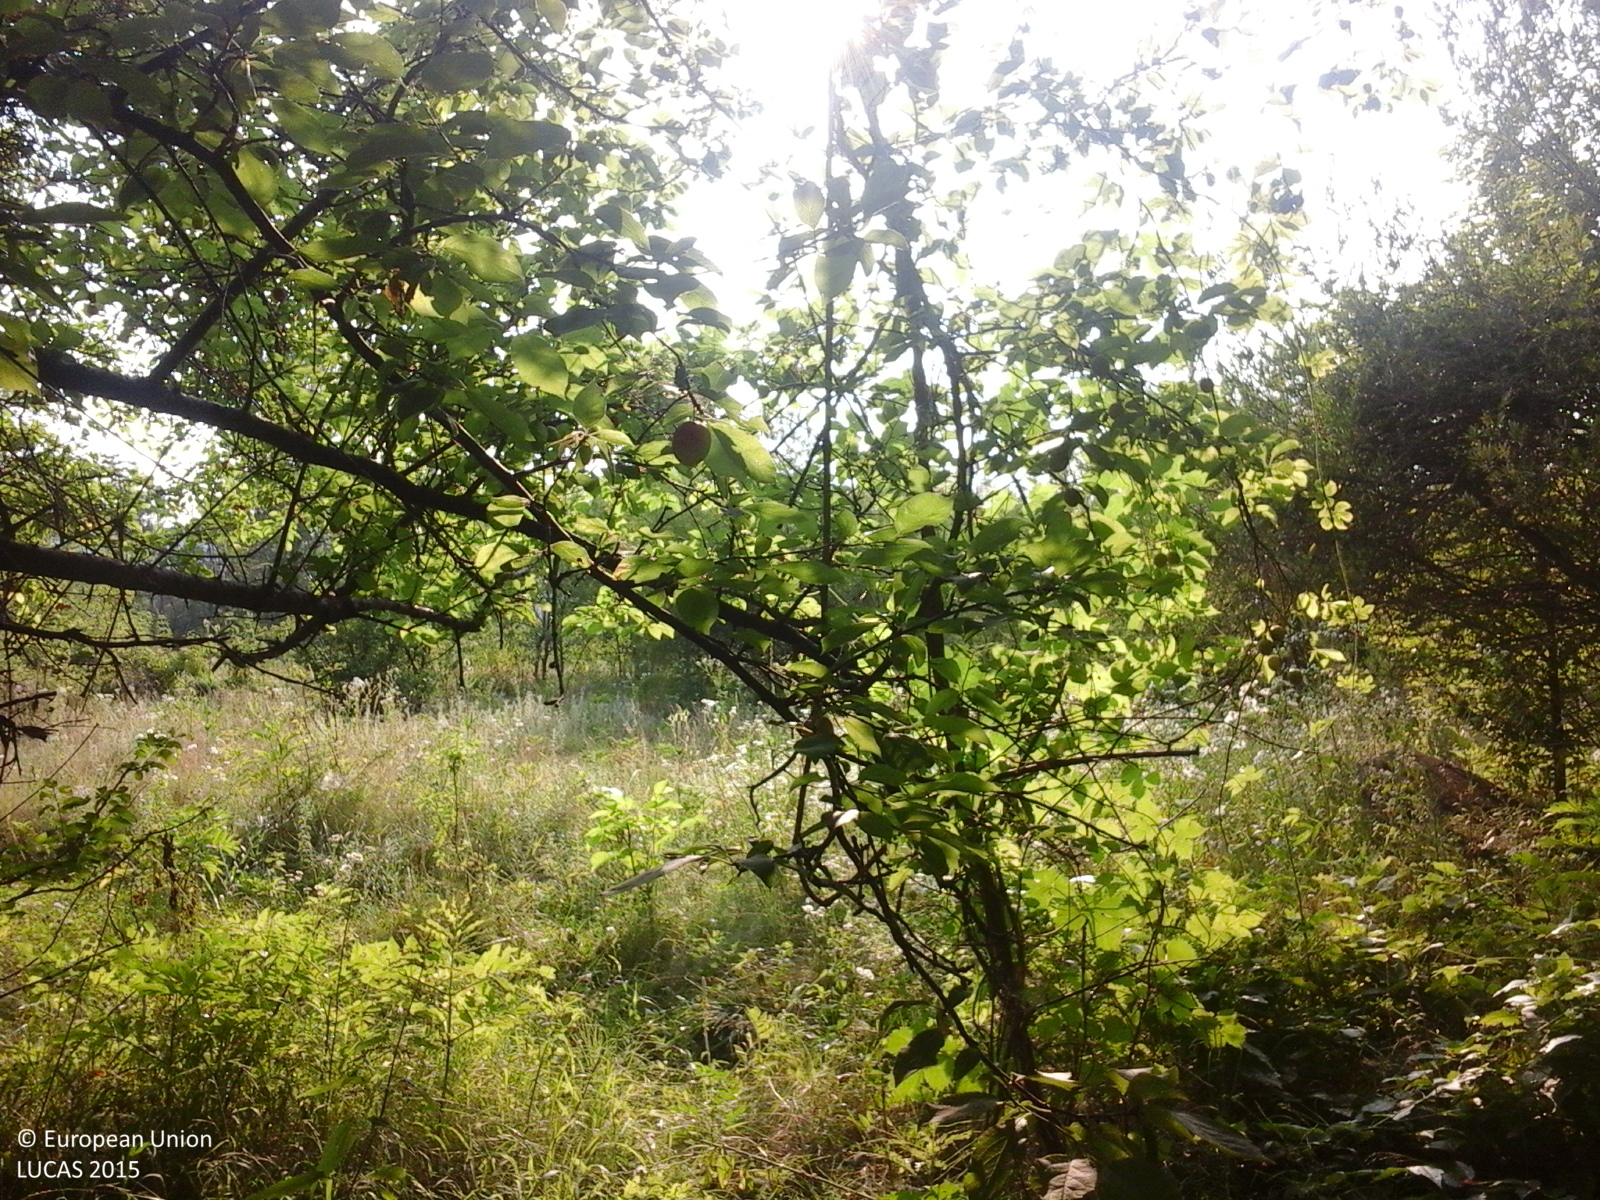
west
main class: Woodland
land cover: Broadleaved woodland
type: beech forest
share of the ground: > 75 %
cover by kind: broadleaved forest trees 100 %
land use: Forestry
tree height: > 5 m
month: July
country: RO
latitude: 45.0937
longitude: 24.5500
